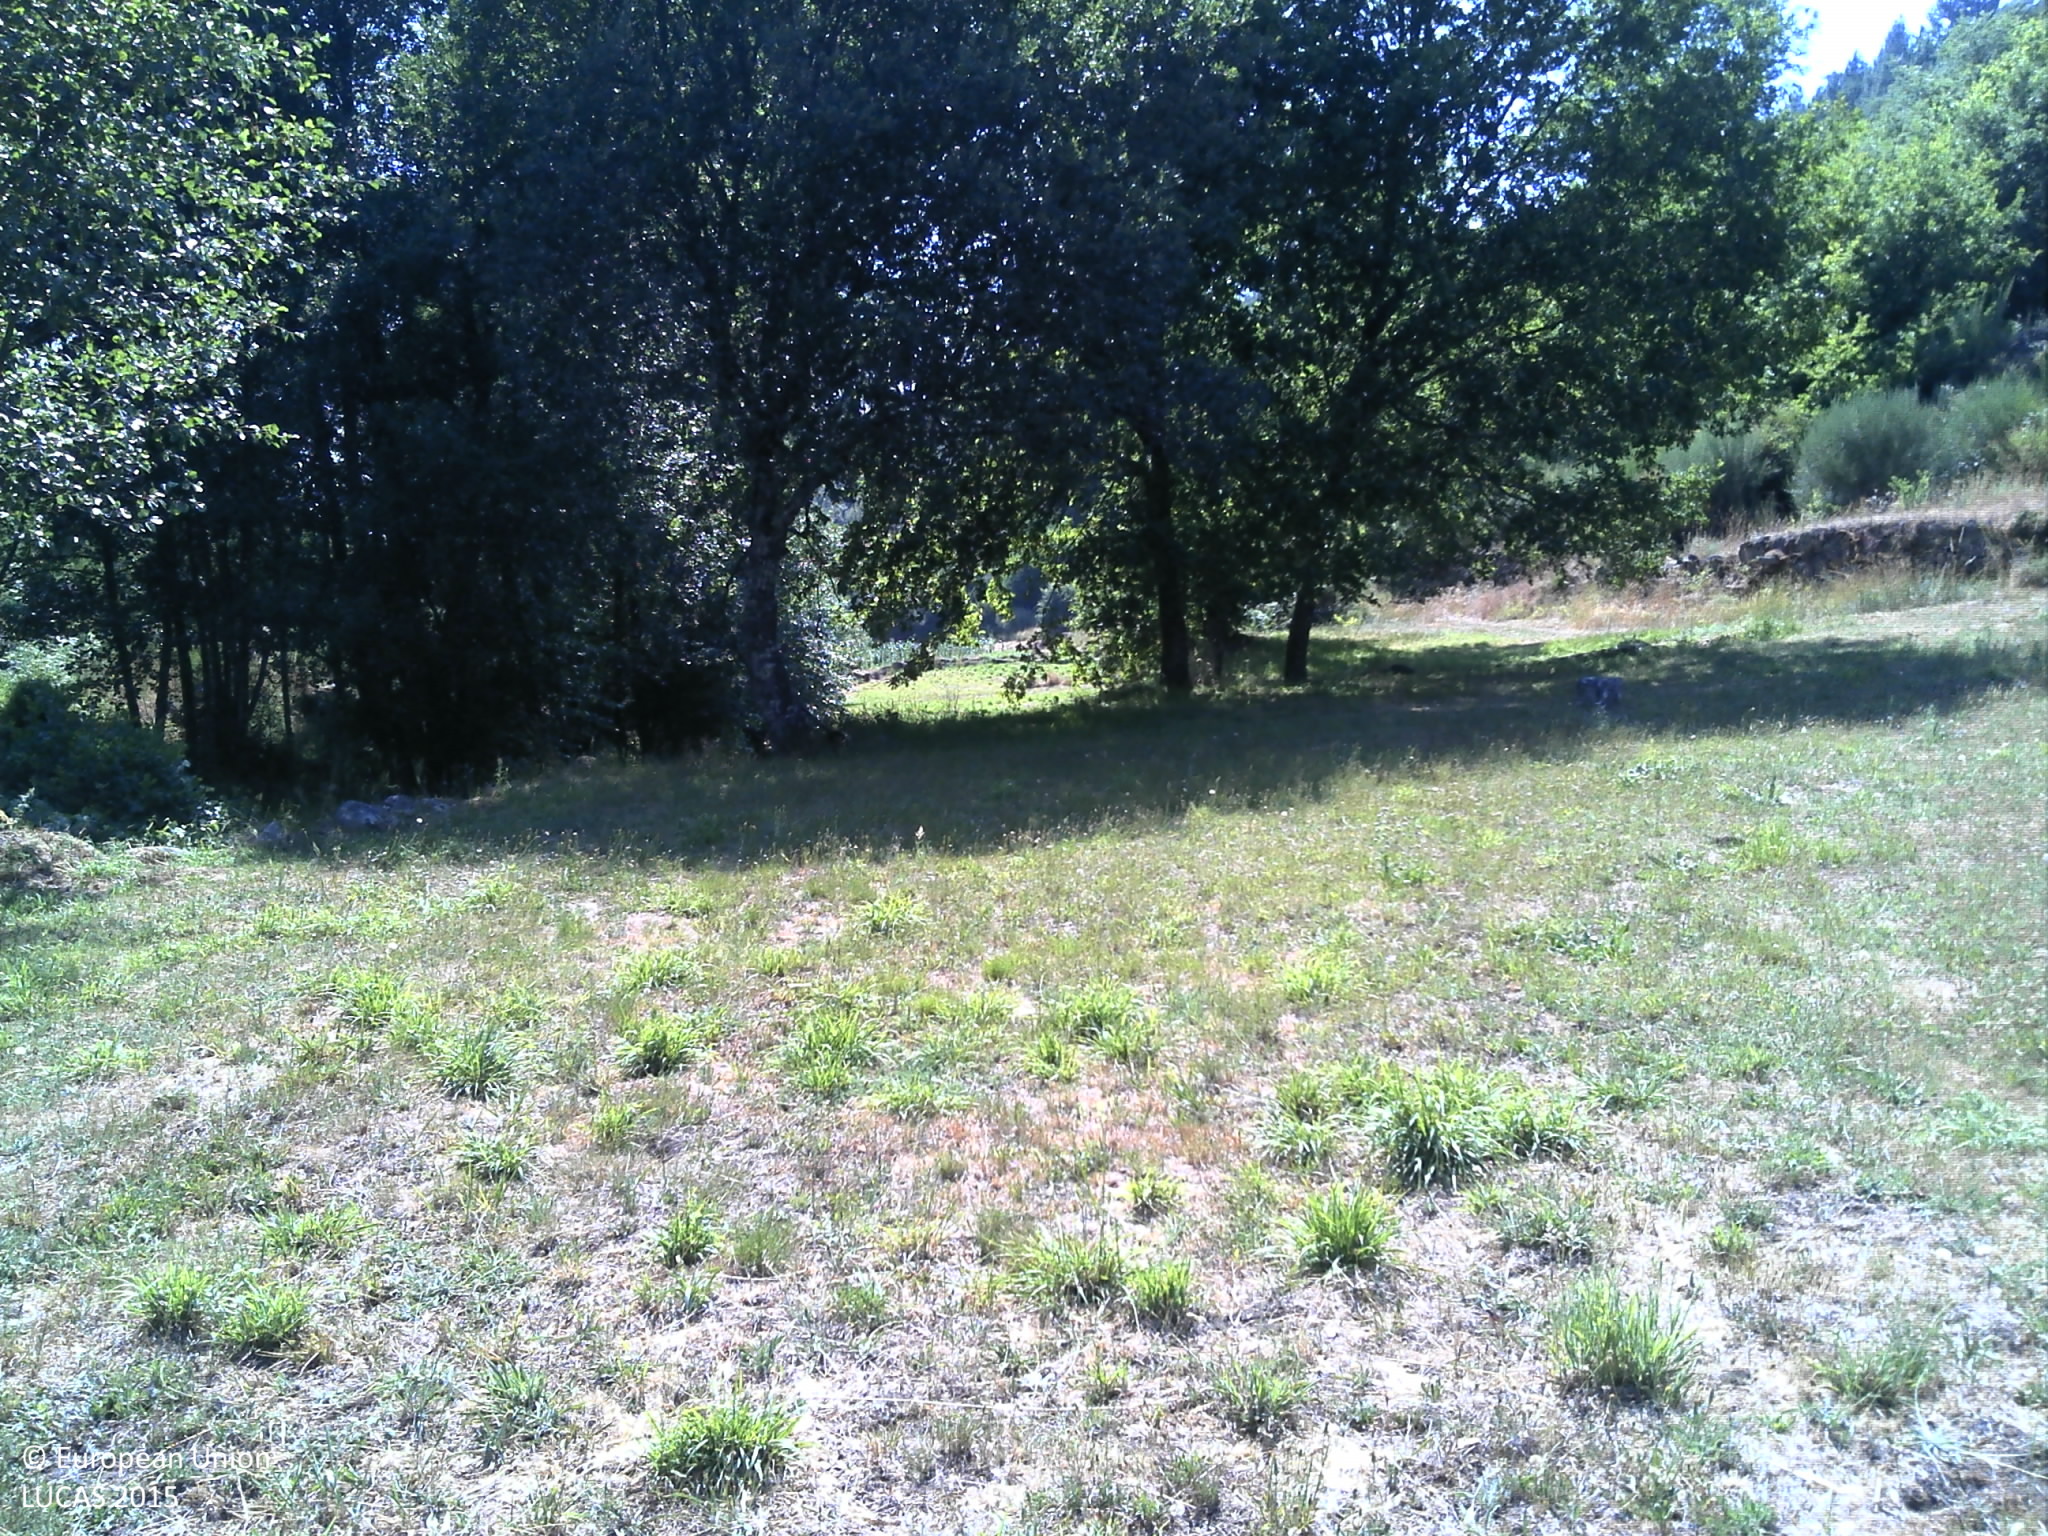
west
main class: Grassland
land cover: Grassland without tree/shrub cover
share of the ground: > 75 %
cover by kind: herbaceous plants 100 %
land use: Agriculture (excluding fallow land and kitchen gardens)
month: July
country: PT
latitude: 40.9053
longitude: -7.8511
